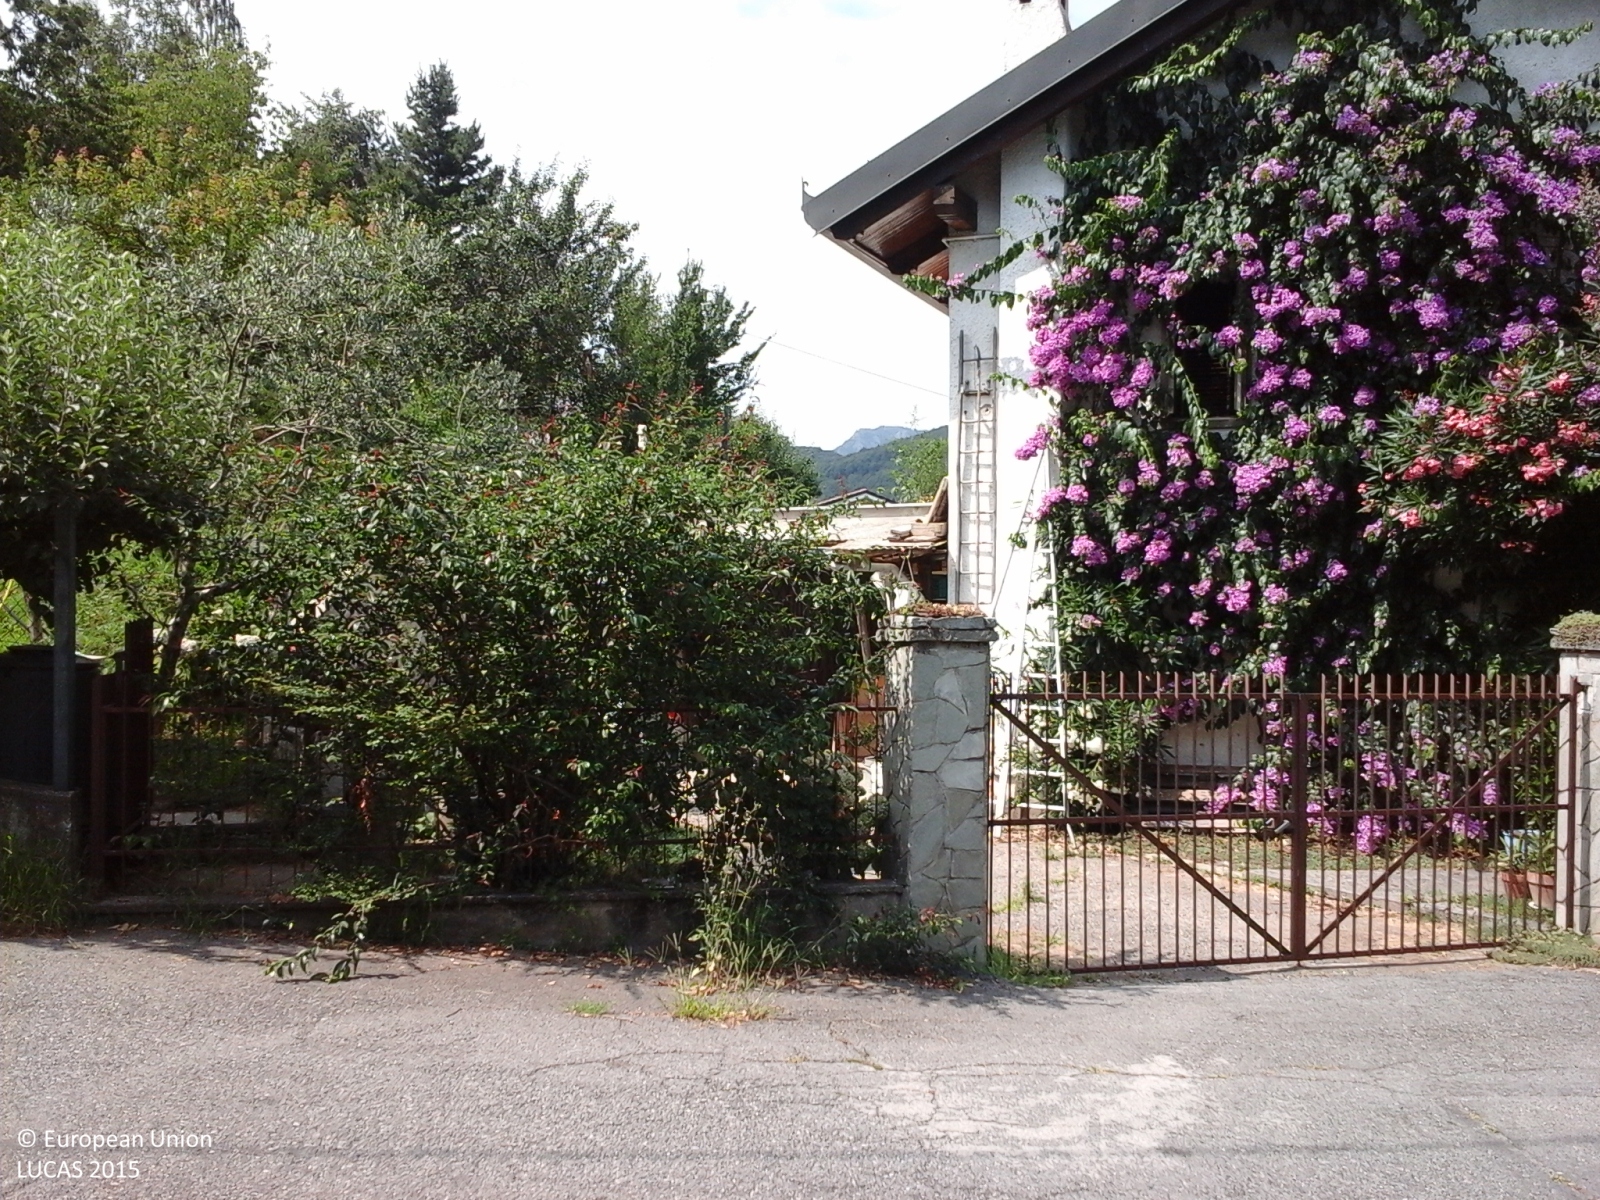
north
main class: Woodland
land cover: Broadleaved woodland
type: thermophilous deciduous forest
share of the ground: > 75 %
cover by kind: broadleaved forest trees 100 %
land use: Semi-natural and natural areas not in use
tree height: > 5 m
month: July
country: IT
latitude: 44.9110
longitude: 7.3069
